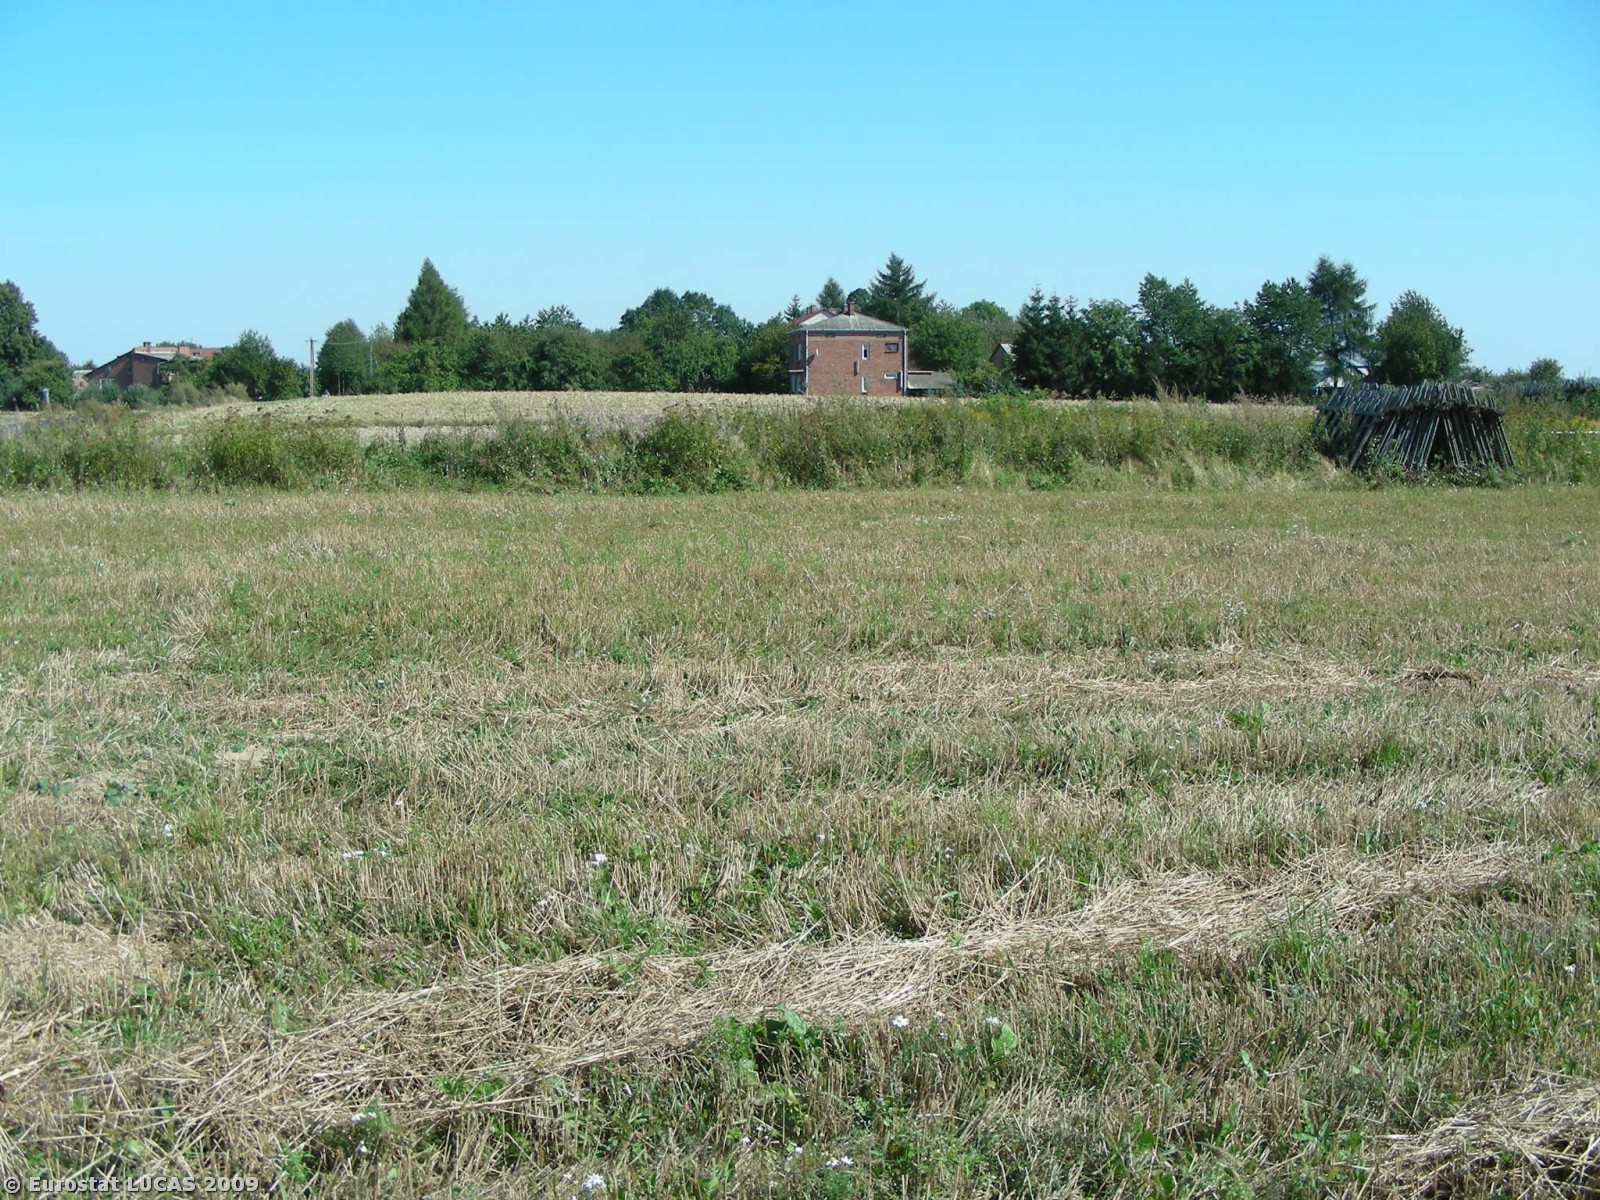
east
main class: Cropland
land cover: Common wheat
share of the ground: < 10 %
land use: Agriculture (excluding fallow land and kitchen gardens)
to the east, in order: Common wheat; Abandoned hedges; Common wheat; Abandoned hedges; Railways; Abandoned hedges; Paved roads, cycling and walking lanes; Common wheat; Grass margins; Common wheat; Fences; Artificial constructions in urban areas; Fences; Common wheat
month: September
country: PL
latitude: 50.8944
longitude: 22.3331
